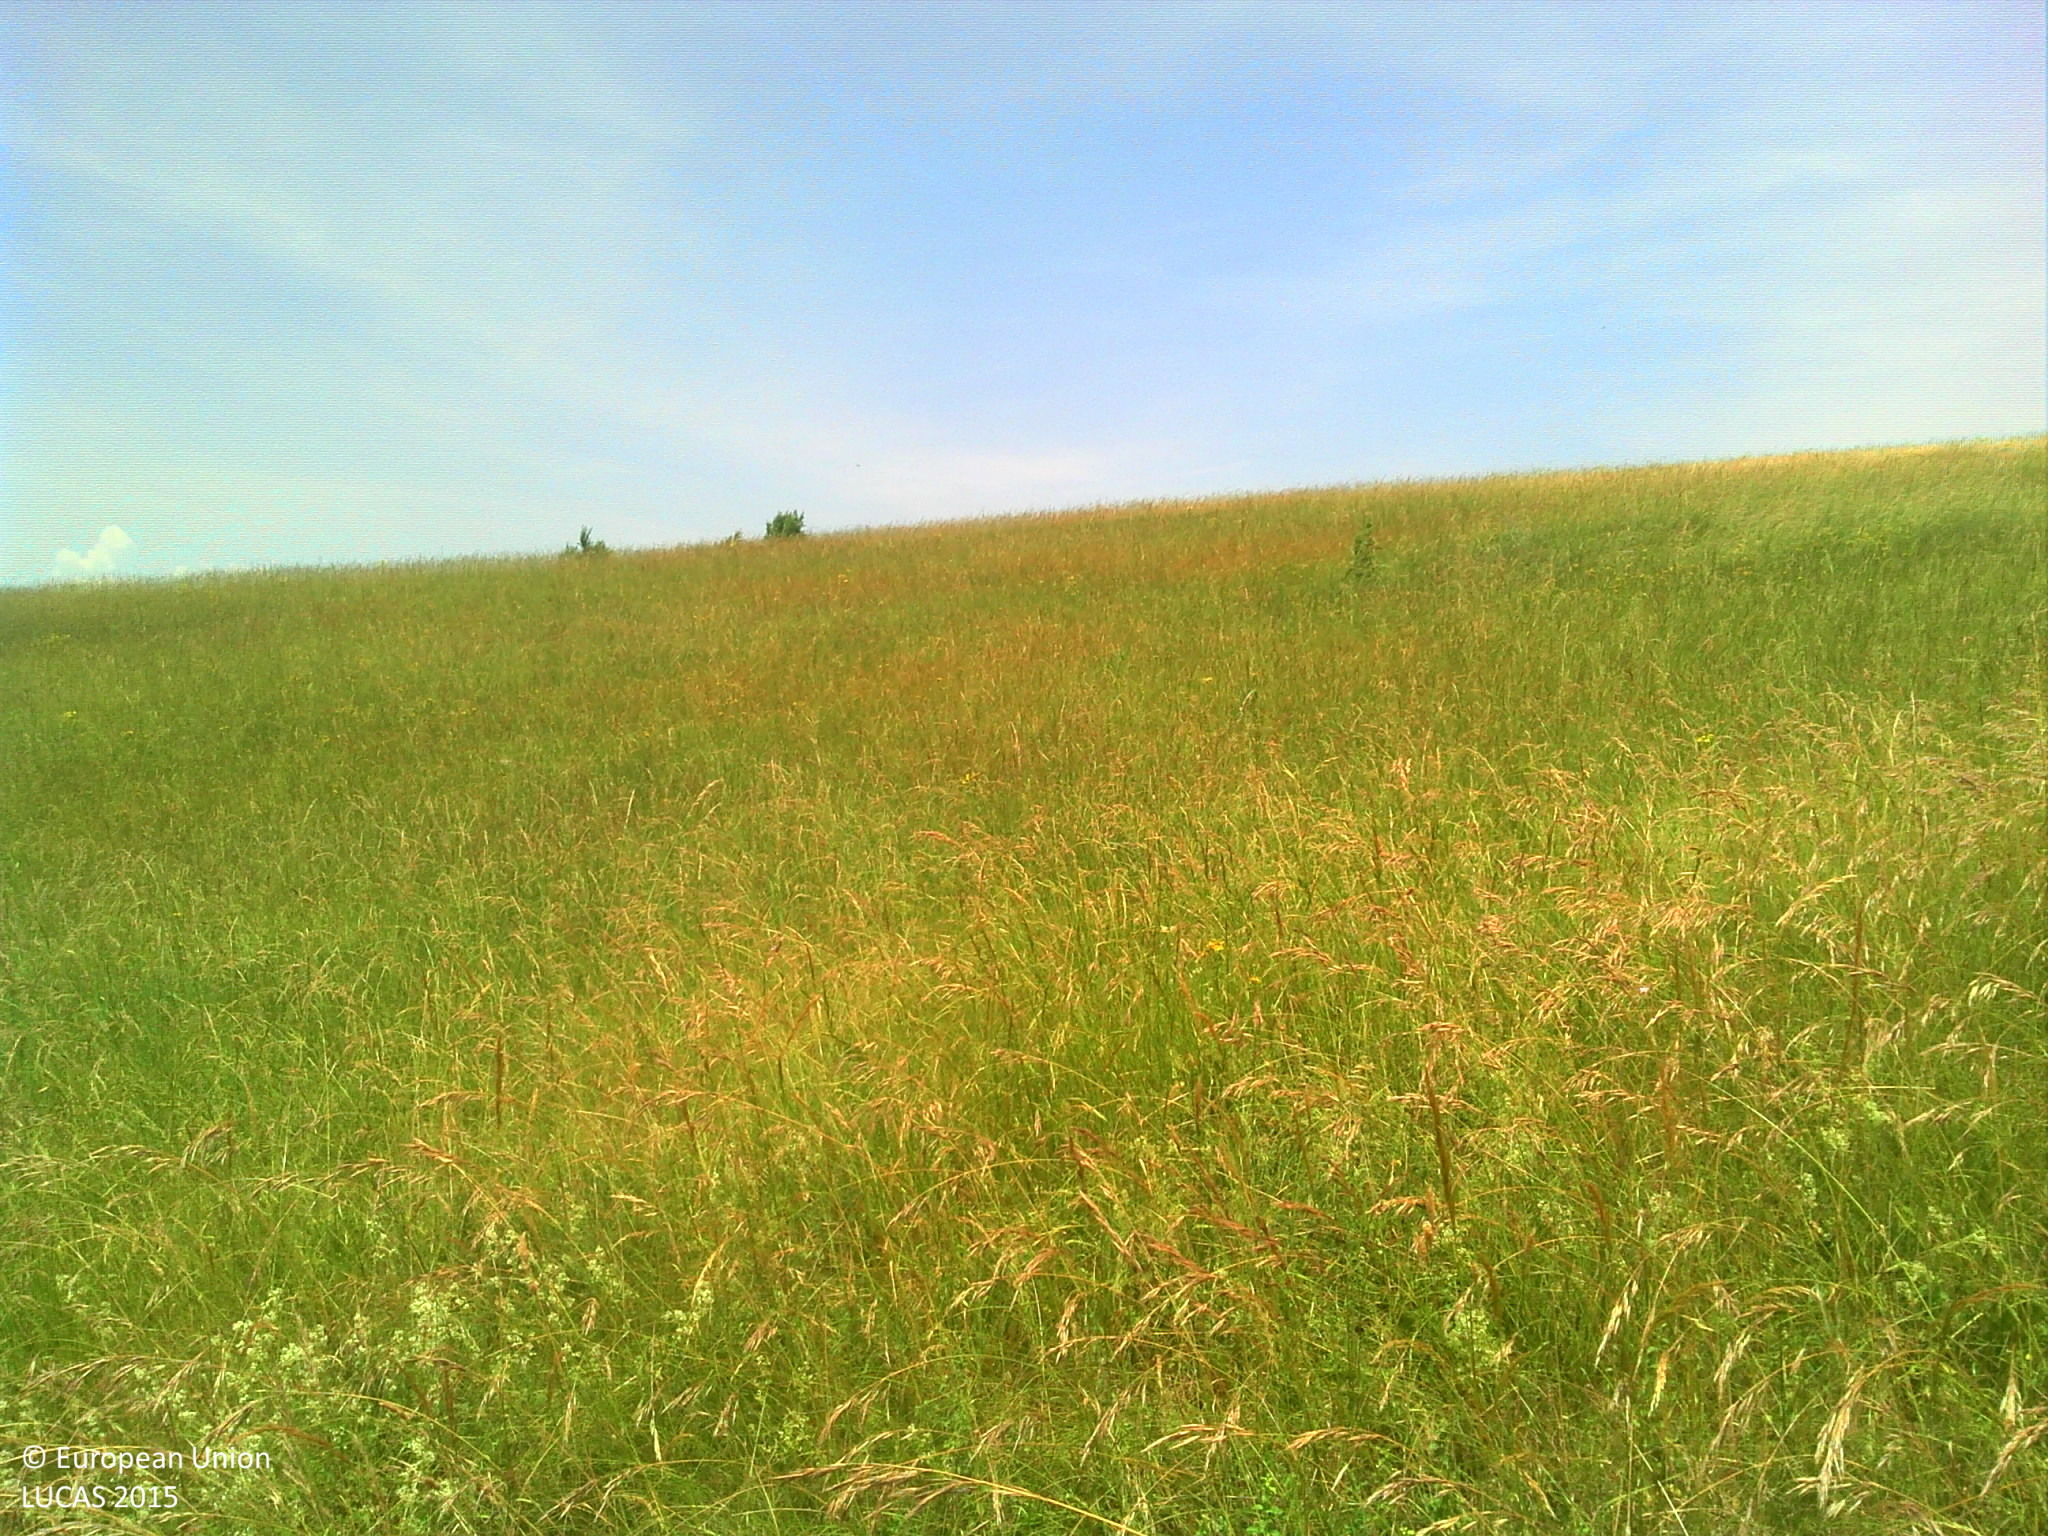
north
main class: Grassland
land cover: Grassland without tree/shrub cover
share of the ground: > 75 %
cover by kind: herbaceous plants 100 %
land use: Agriculture (excluding fallow land and kitchen gardens)
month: June
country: FR
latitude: 43.9543
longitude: 1.5900
